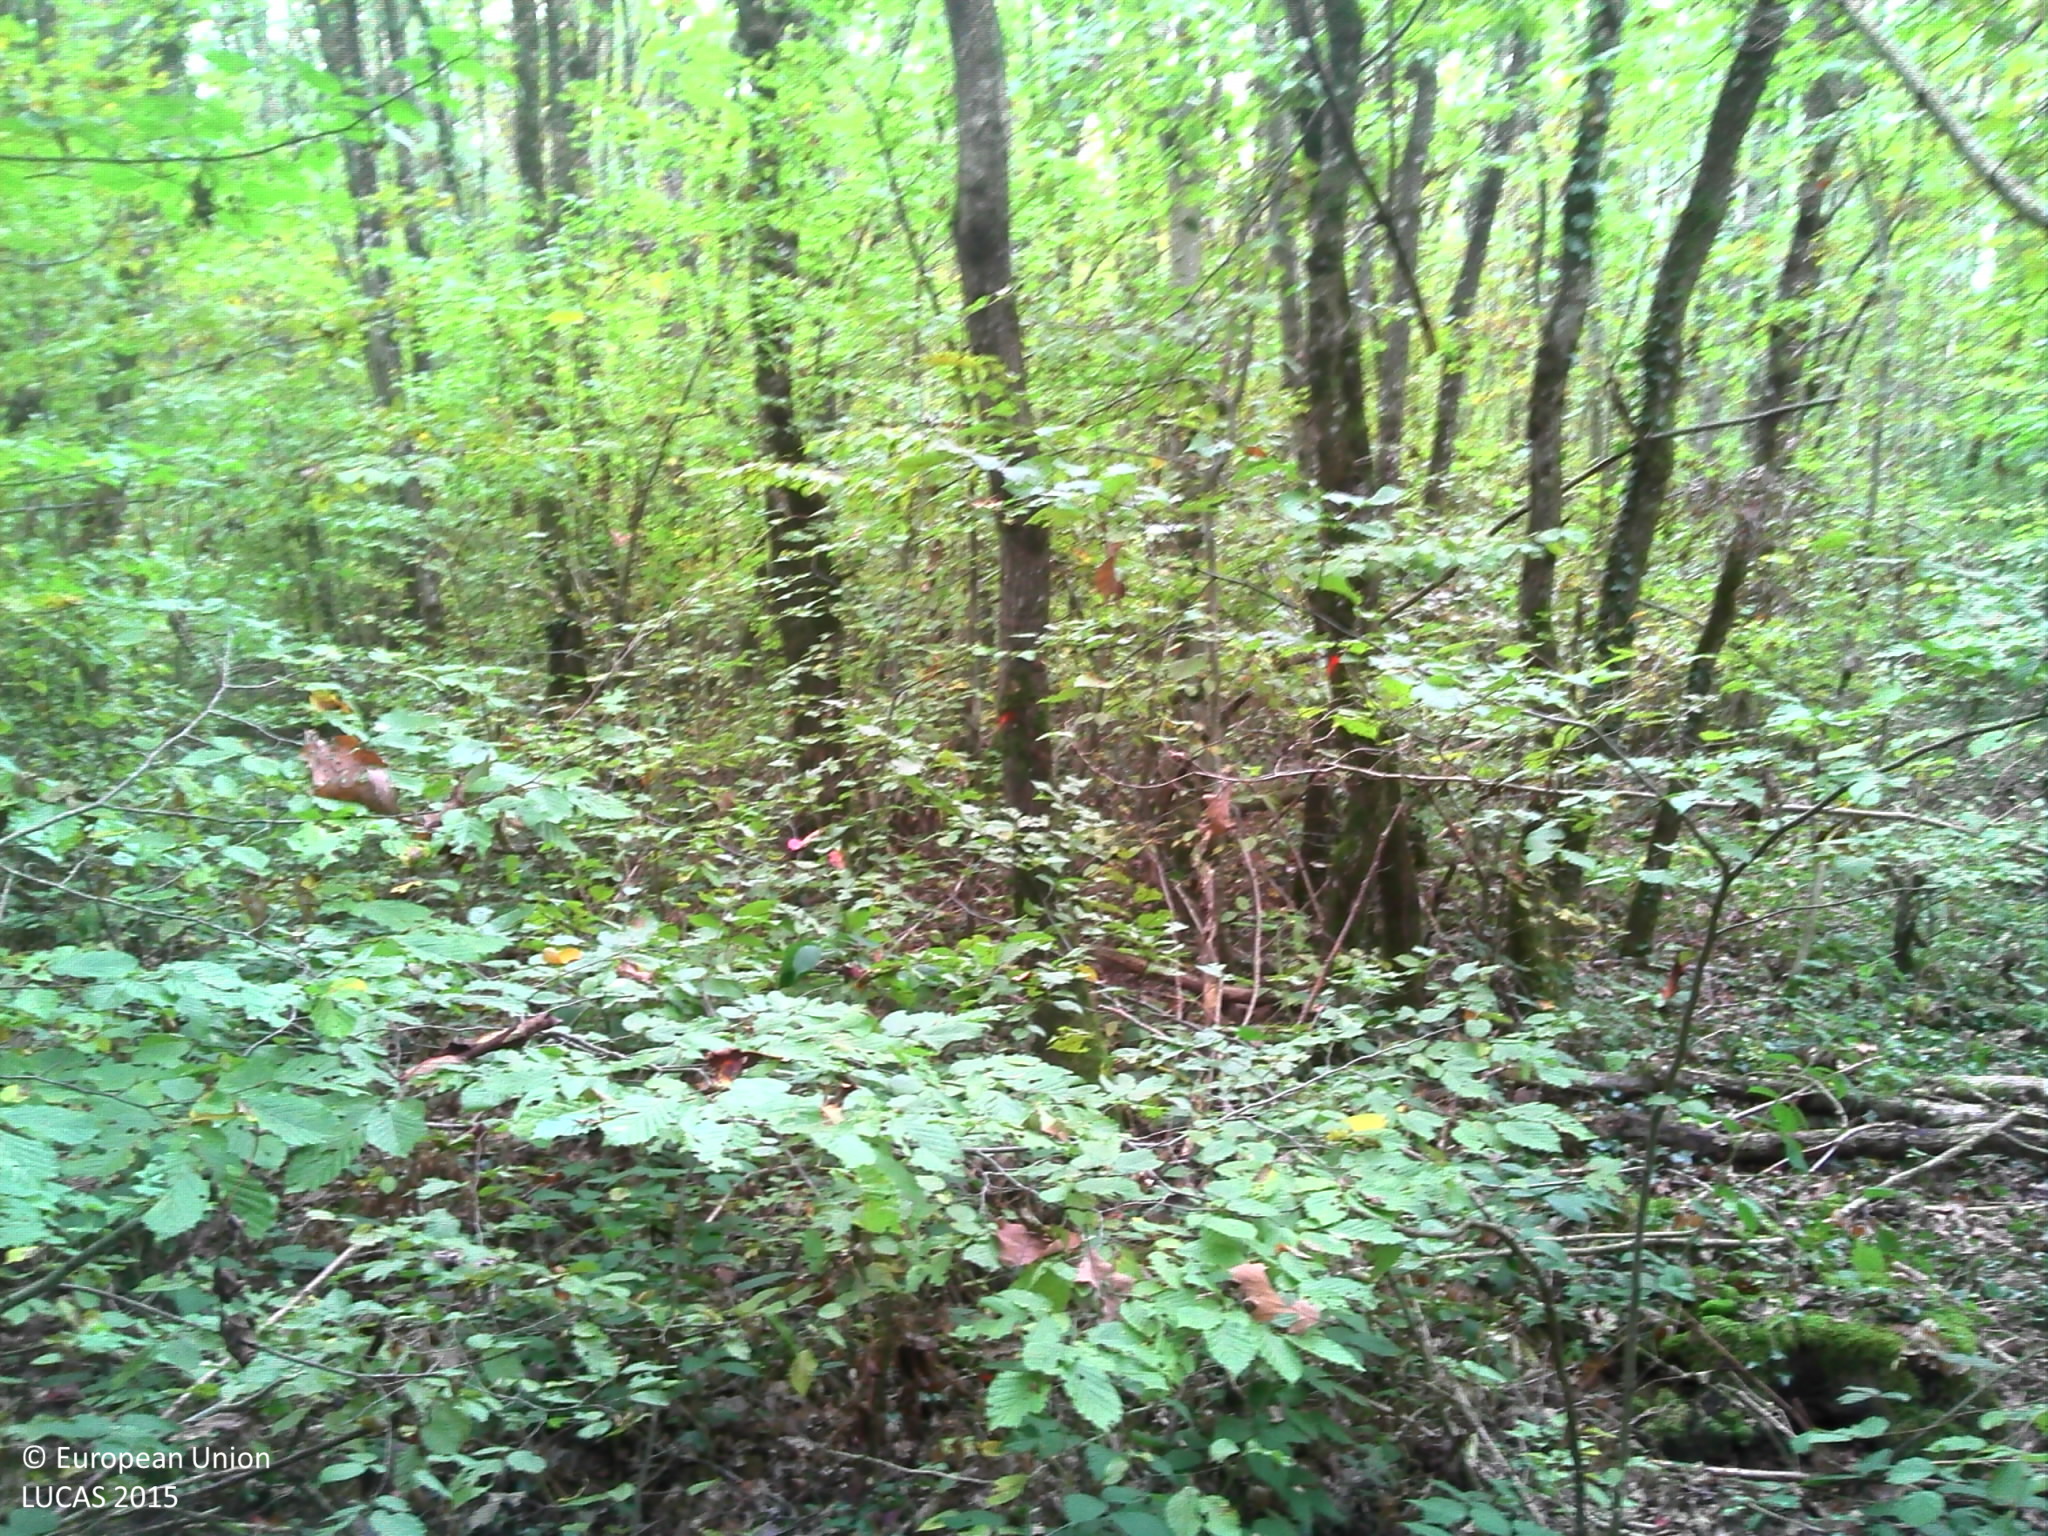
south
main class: Woodland
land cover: Broadleaved woodland
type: mesophytic deciduous forest
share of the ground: > 75 %
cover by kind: broadleaved forest trees 100 %
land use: Forestry
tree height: > 5 m
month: October
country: FR
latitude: 47.5514
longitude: 5.4162
